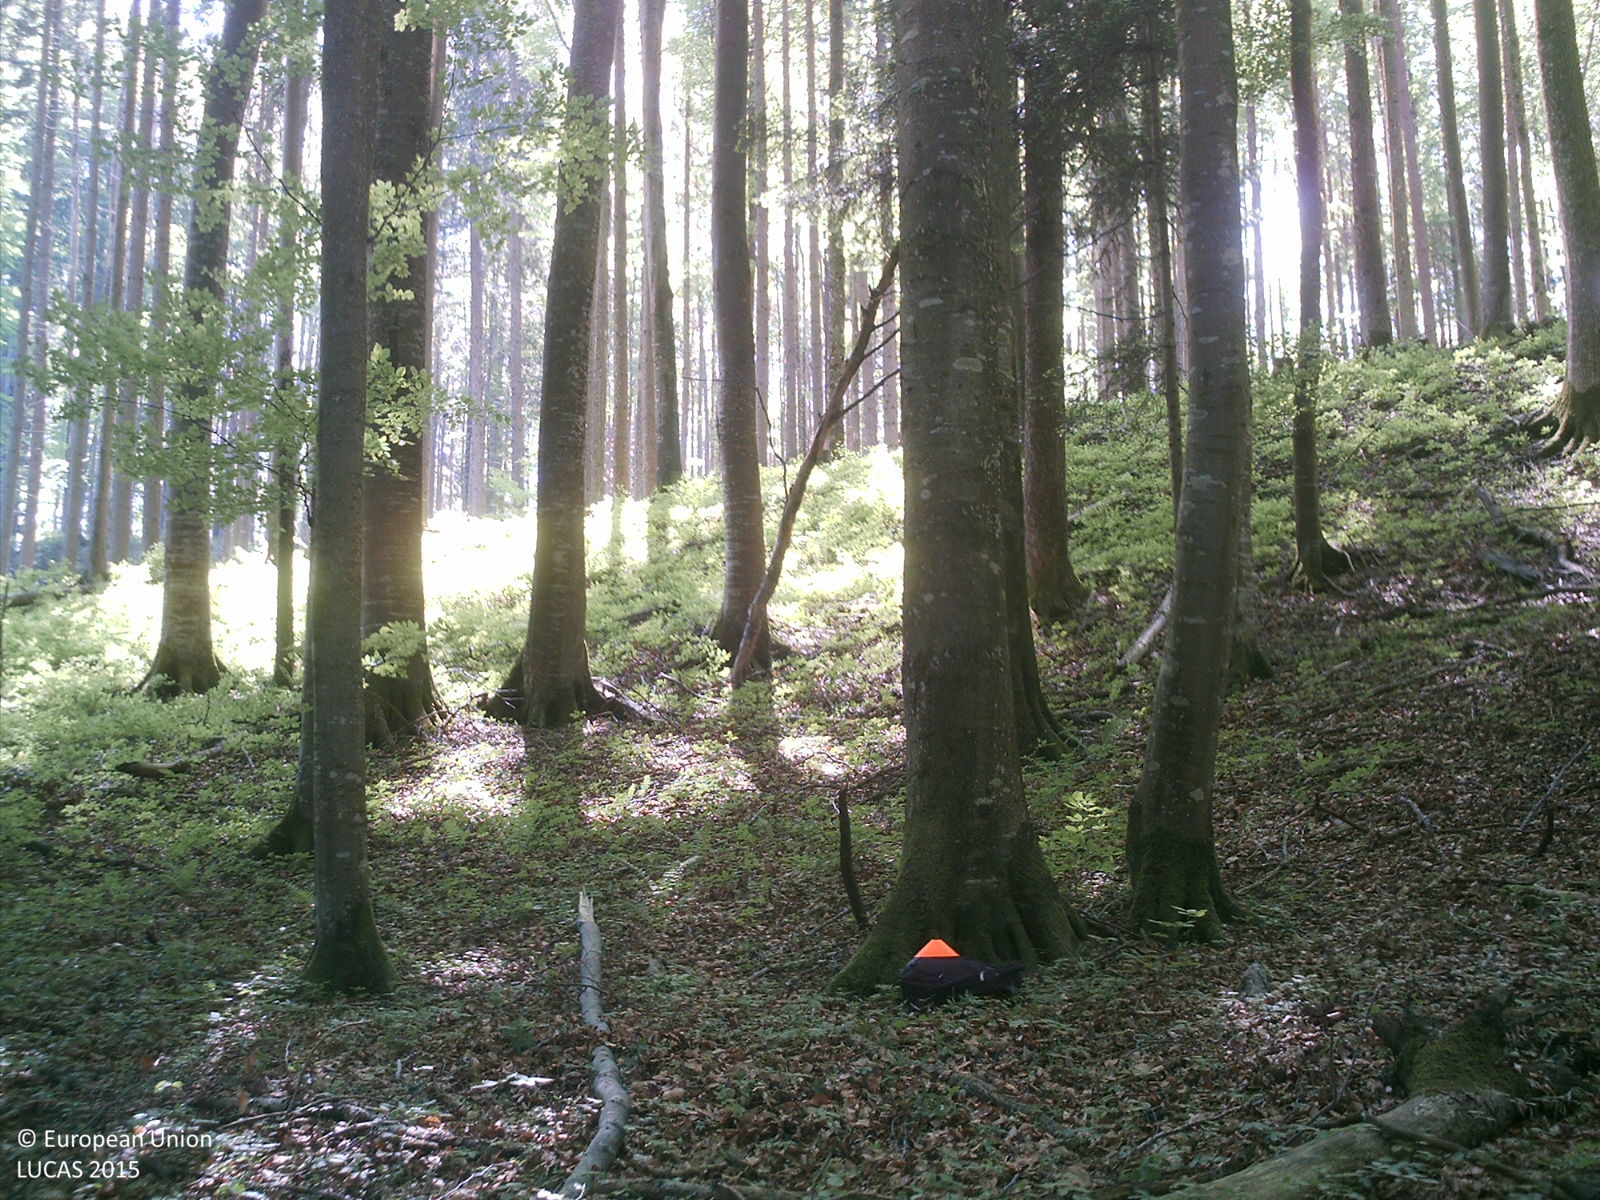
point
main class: Woodland
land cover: Broadleaved woodland
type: mountainous beech forest
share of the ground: > 75 %
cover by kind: broadleaved forest trees 90 %, shrubs 5 %, herbaceous plants 5 %
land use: Forestry
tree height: > 5 m
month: May
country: AT
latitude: 47.8579
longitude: 14.1295
